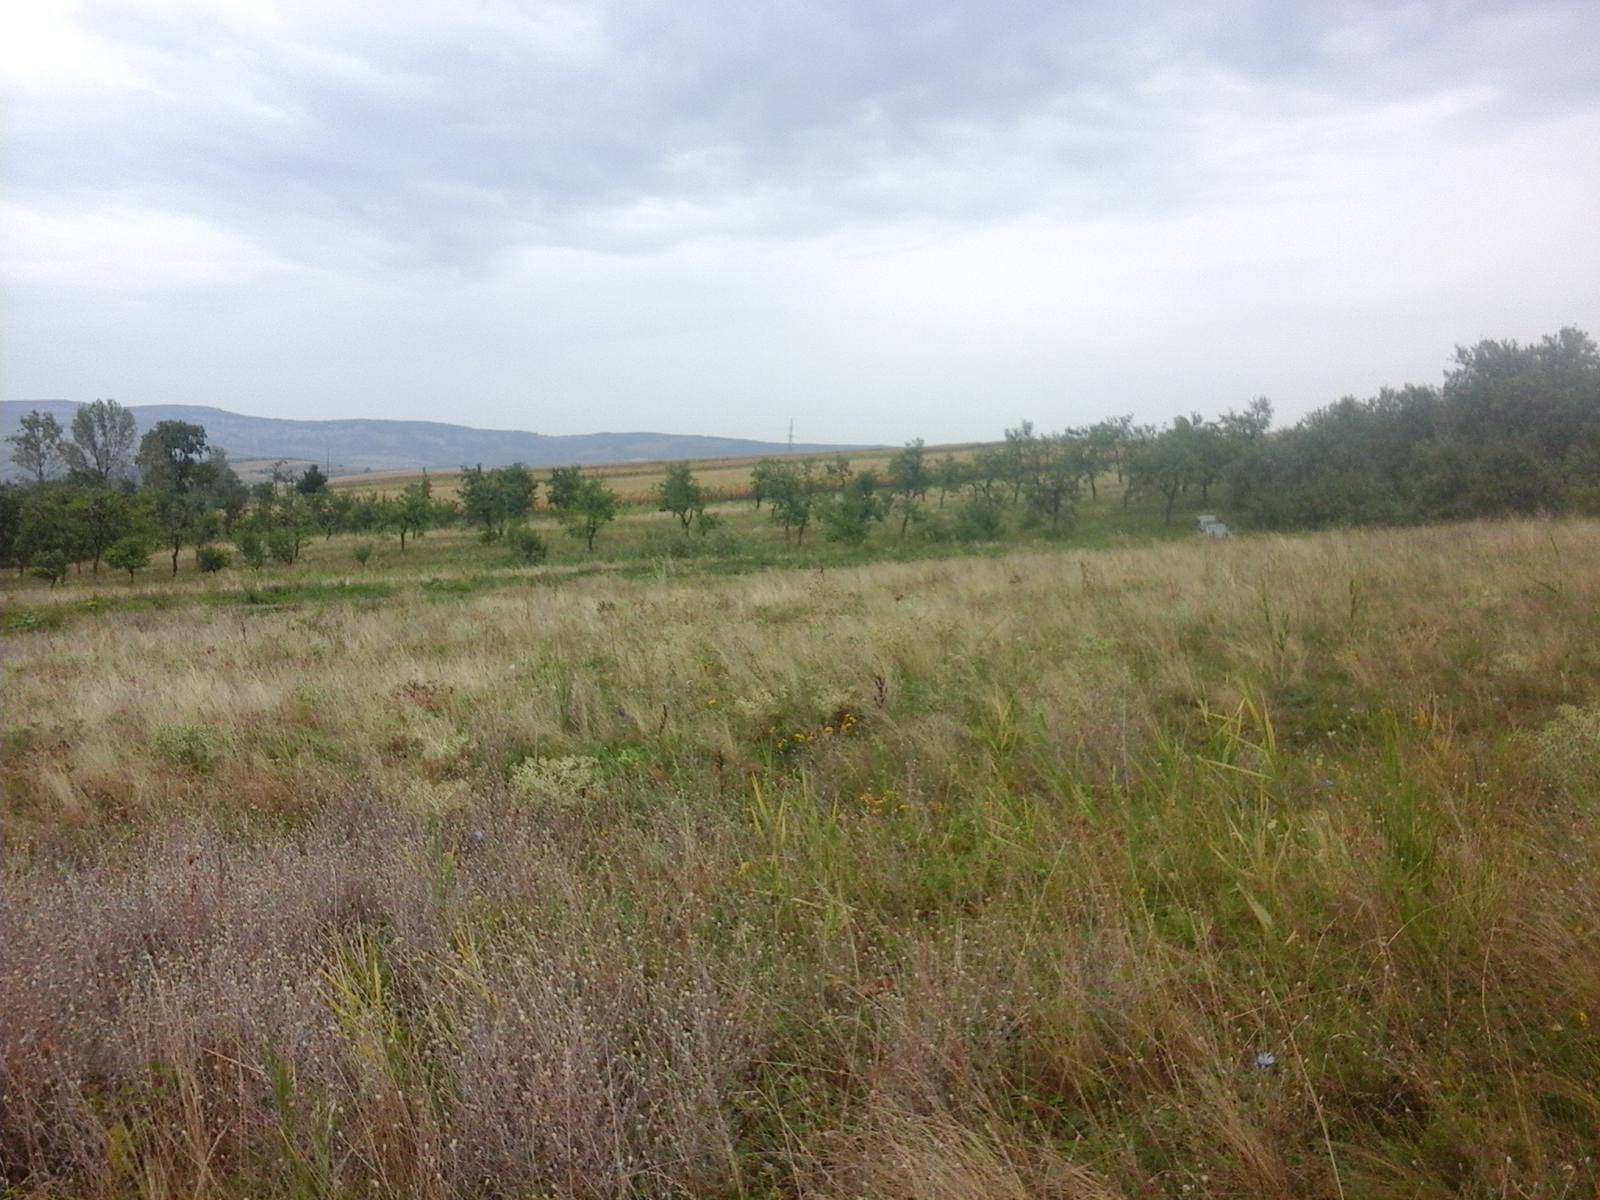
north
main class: Grassland
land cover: Grassland without tree/shrub cover
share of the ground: > 75 %
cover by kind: herbaceous plants 100 %
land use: Agriculture (excluding fallow land and kitchen gardens)
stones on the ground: < 10 %
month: September
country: RO
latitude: 47.2752
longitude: 22.6291
